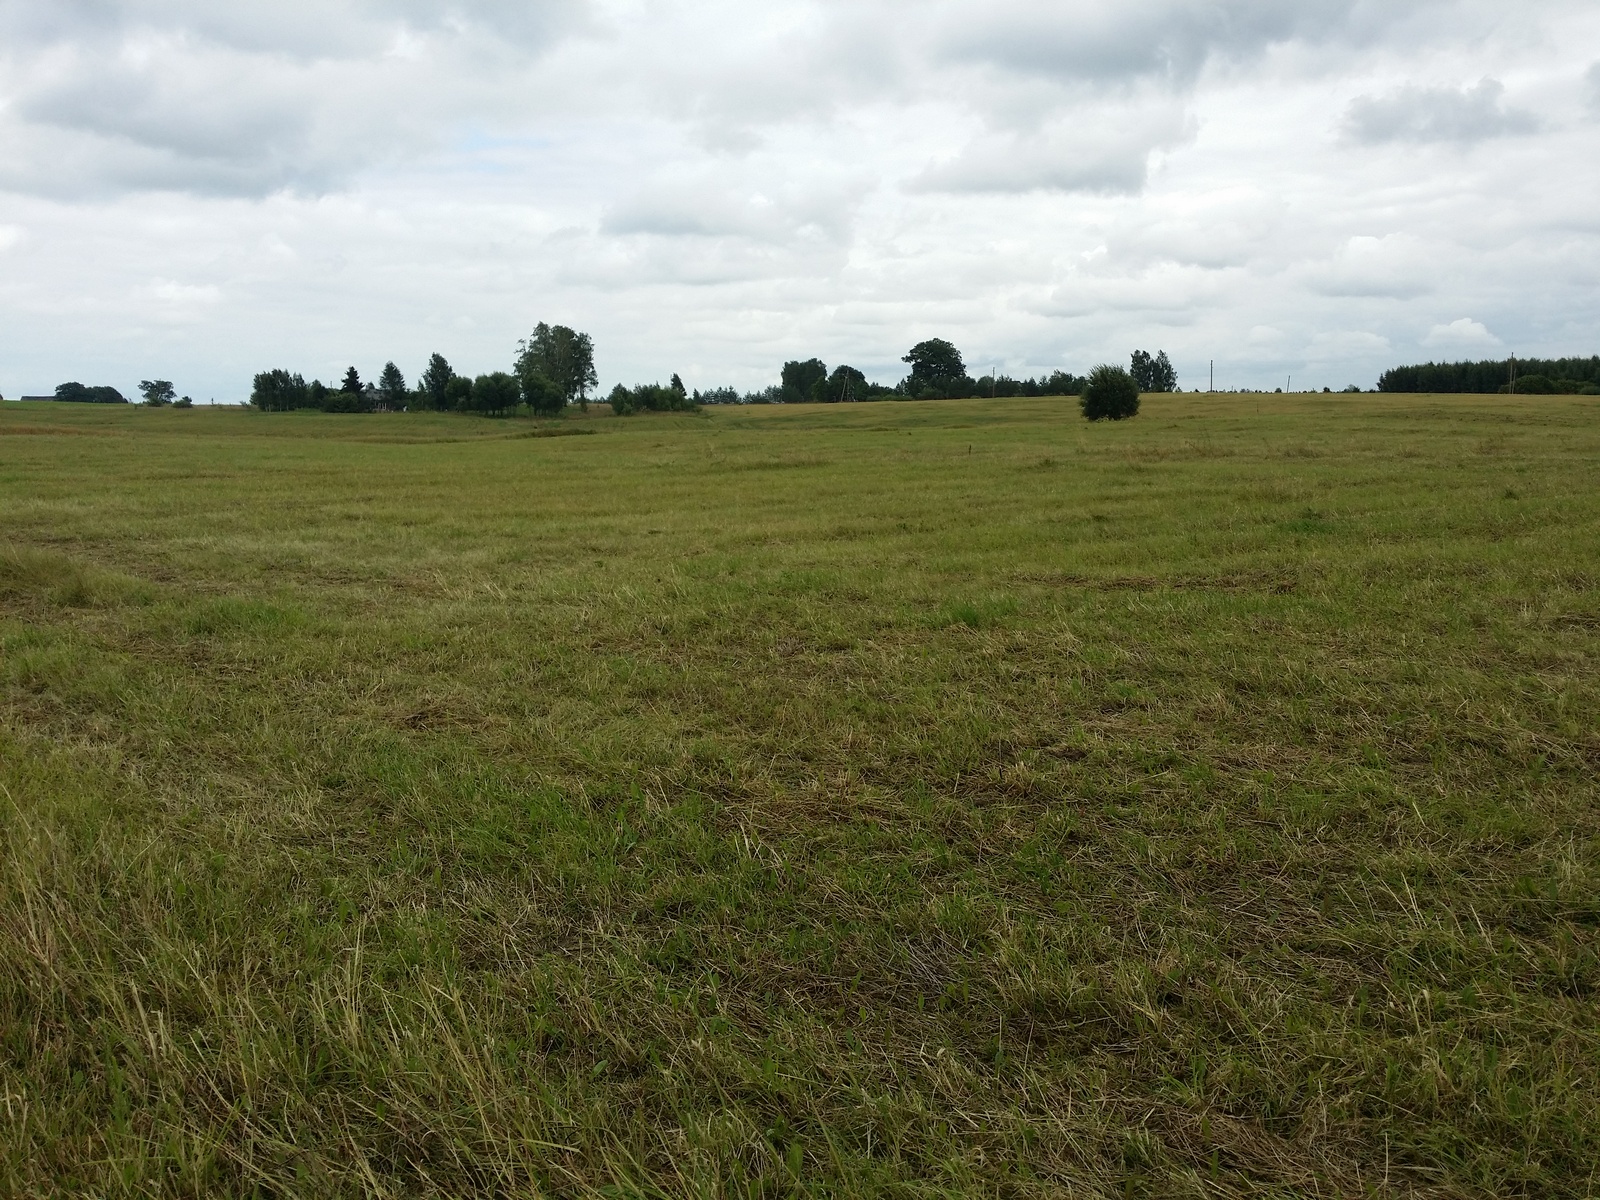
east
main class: Grassland
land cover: Grassland without tree/shrub cover
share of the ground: > 75 %
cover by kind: herbaceous plants 90 %, unconsolidated bare surface 10 %
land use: Agriculture (excluding fallow land and kitchen gardens)
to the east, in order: Grassland without tree/shrub cover; Oats; Common wheat
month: August
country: LV
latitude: 57.1932
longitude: 26.7500
